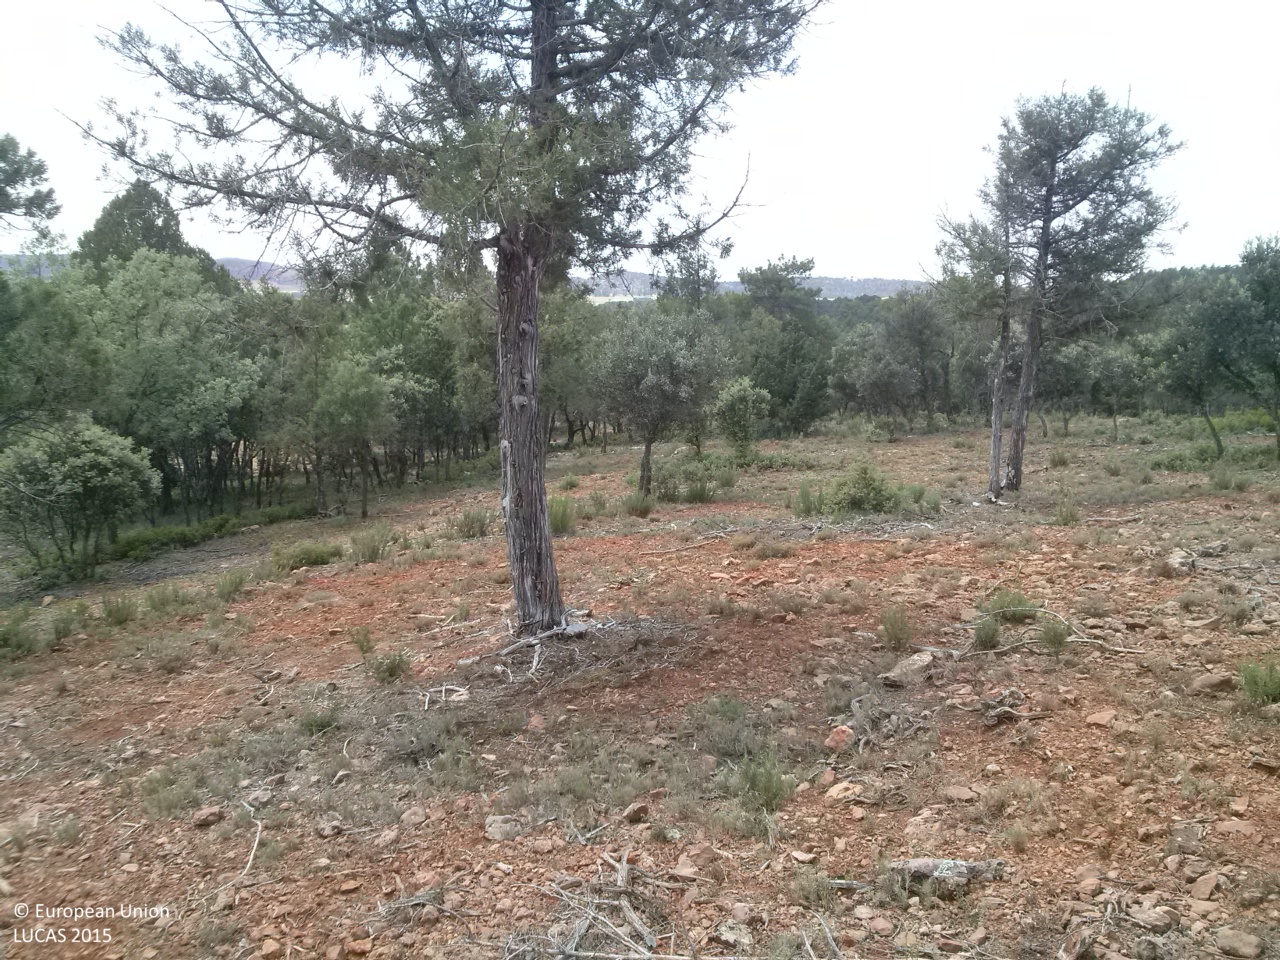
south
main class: Woodland
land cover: Other mixed woodland
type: broadleaved evergreen forest
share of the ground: 25 - 50 %
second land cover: Grassland without tree/shrub cover
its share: 25 - 50 %
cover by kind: herbaceous plants 30 %, broadleaved forest trees 20 %, shrubs 20 %, unconsolidated bare surface 20 %, coniferous forest trees 10 %
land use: Forestry
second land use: Agriculture (excluding fallow land and kitchen gardens)
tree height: < 5 m
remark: Clear cut
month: June
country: ES
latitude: 39.9931
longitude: -1.7825
